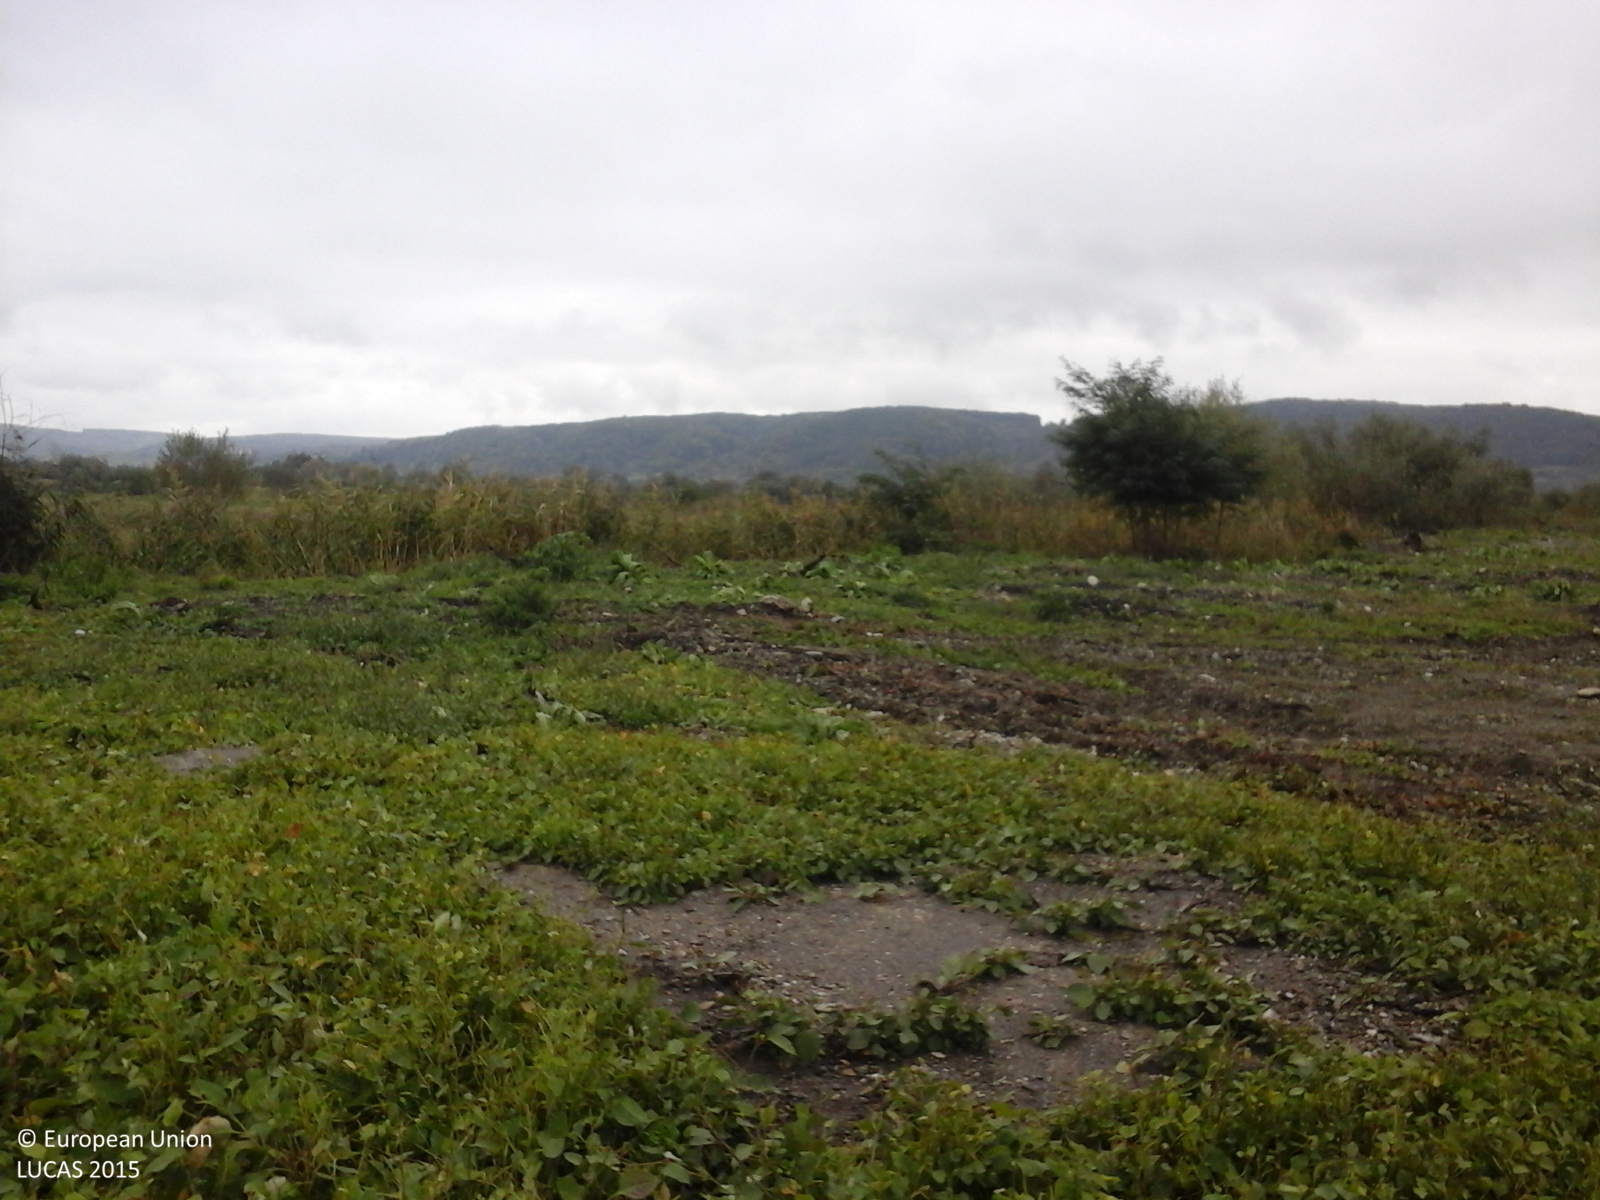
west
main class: Grassland
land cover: Spontaneously vegetated surfaces
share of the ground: > 75 %
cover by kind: herbaceous plants 100 %
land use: Fallow land
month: October
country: RO
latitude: 45.7386
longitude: 24.3833
